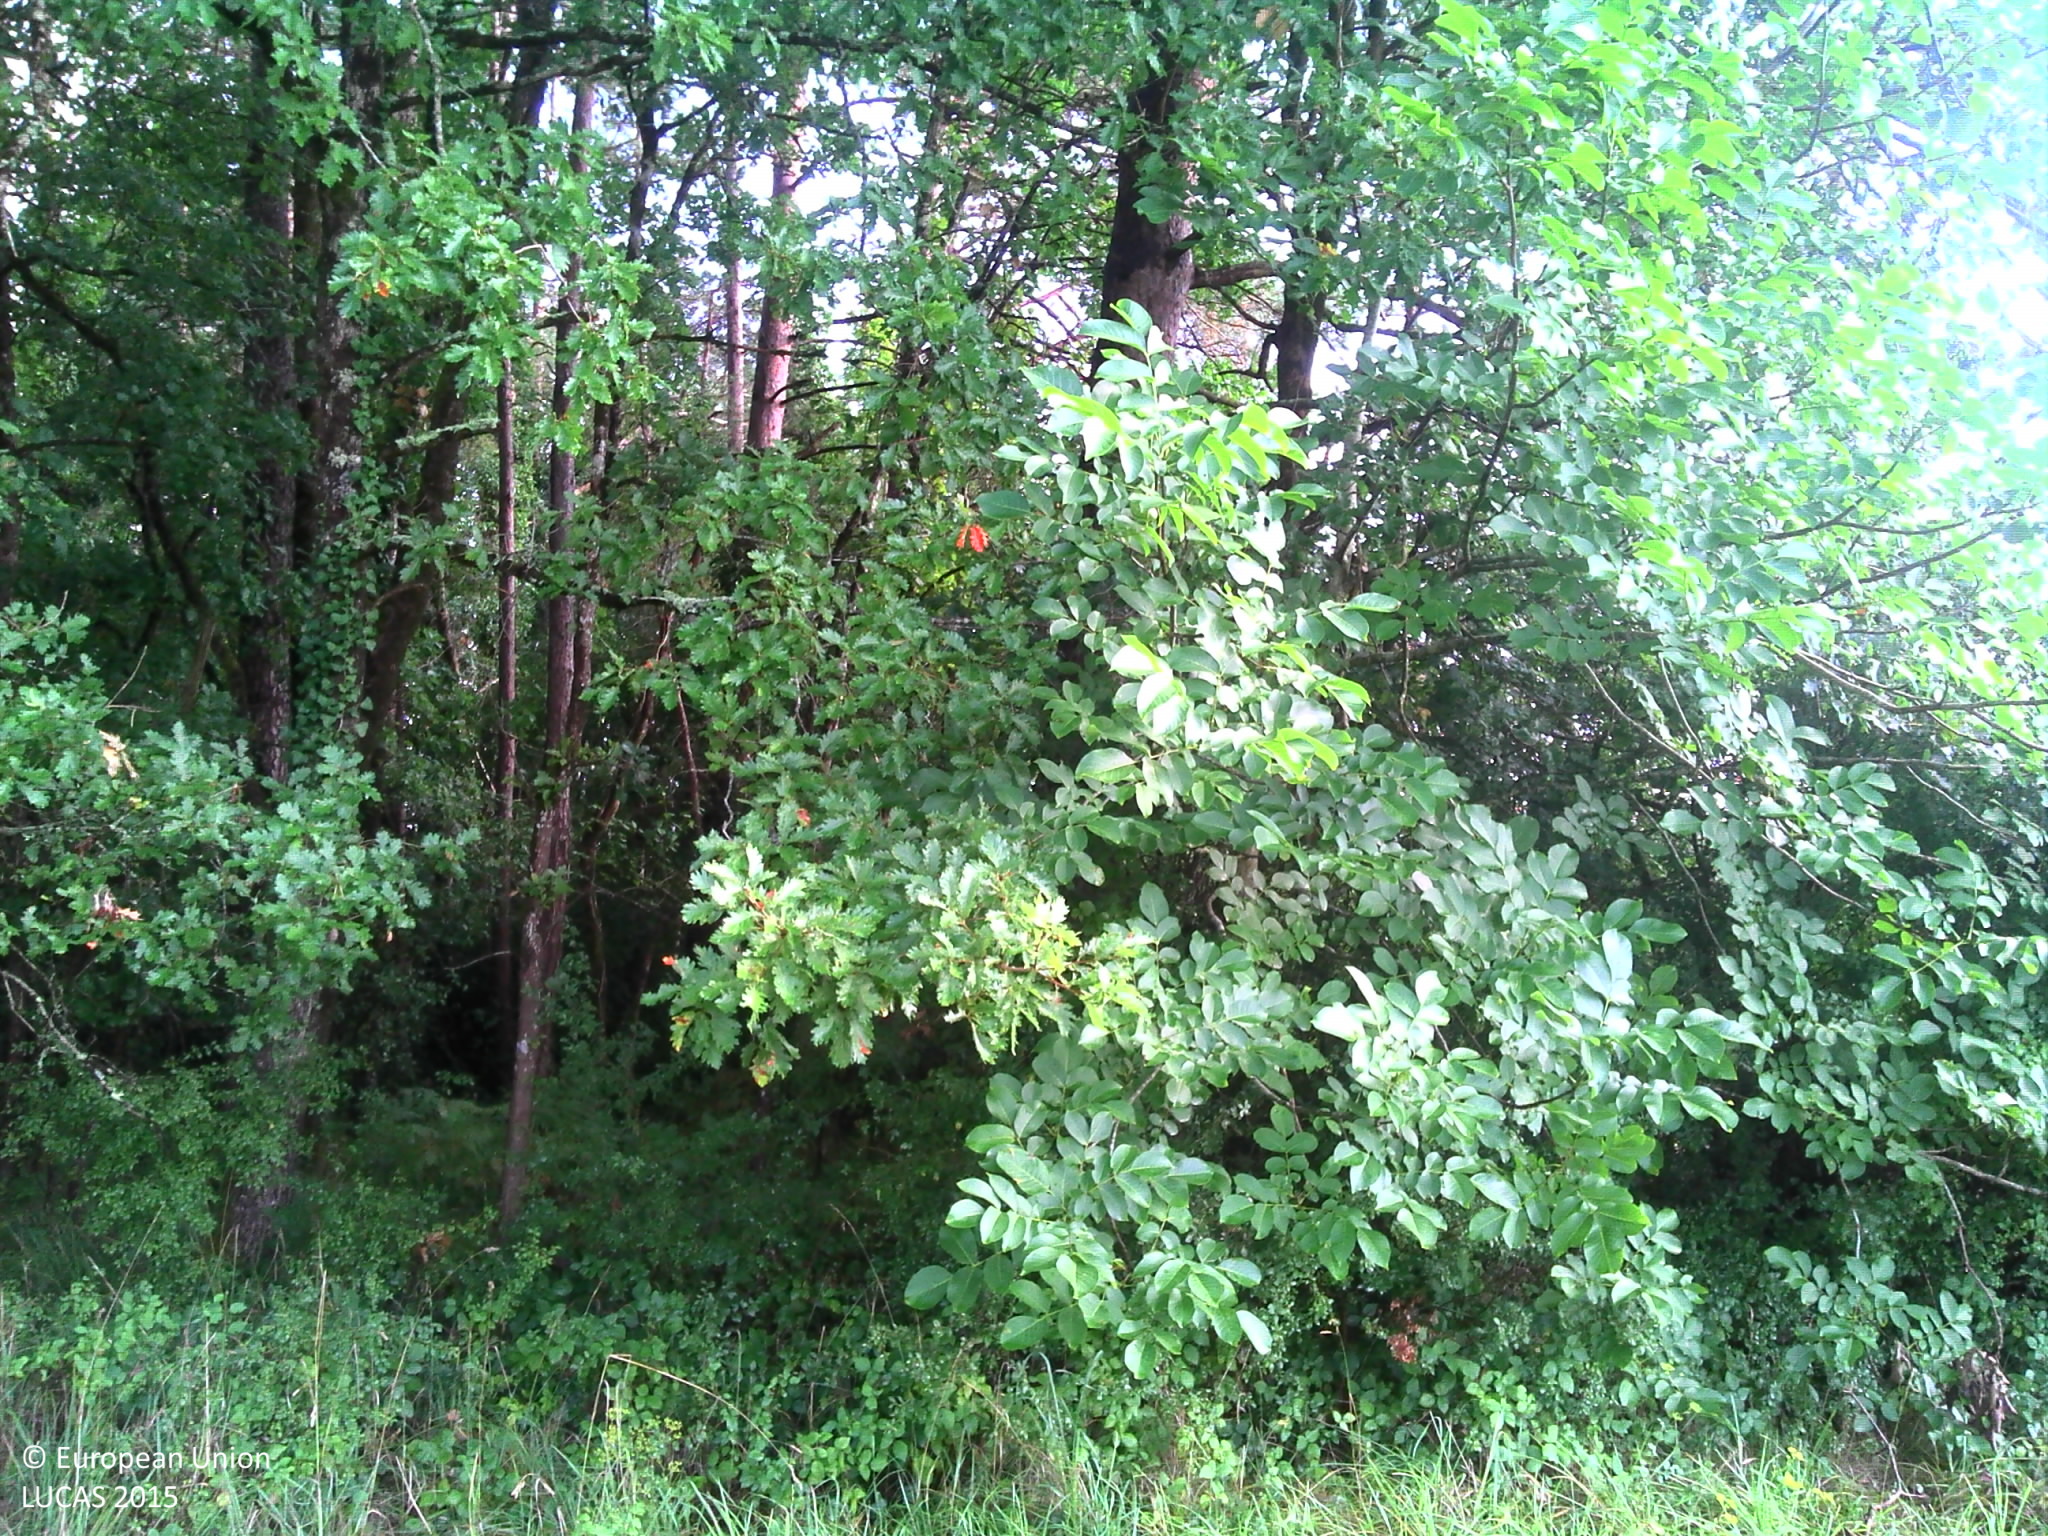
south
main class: Grassland
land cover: Grassland without tree/shrub cover
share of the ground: > 75 %
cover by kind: herbaceous plants 100 %
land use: Agriculture (excluding fallow land and kitchen gardens)
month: August
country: FR
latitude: 45.3993
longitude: 0.6759
